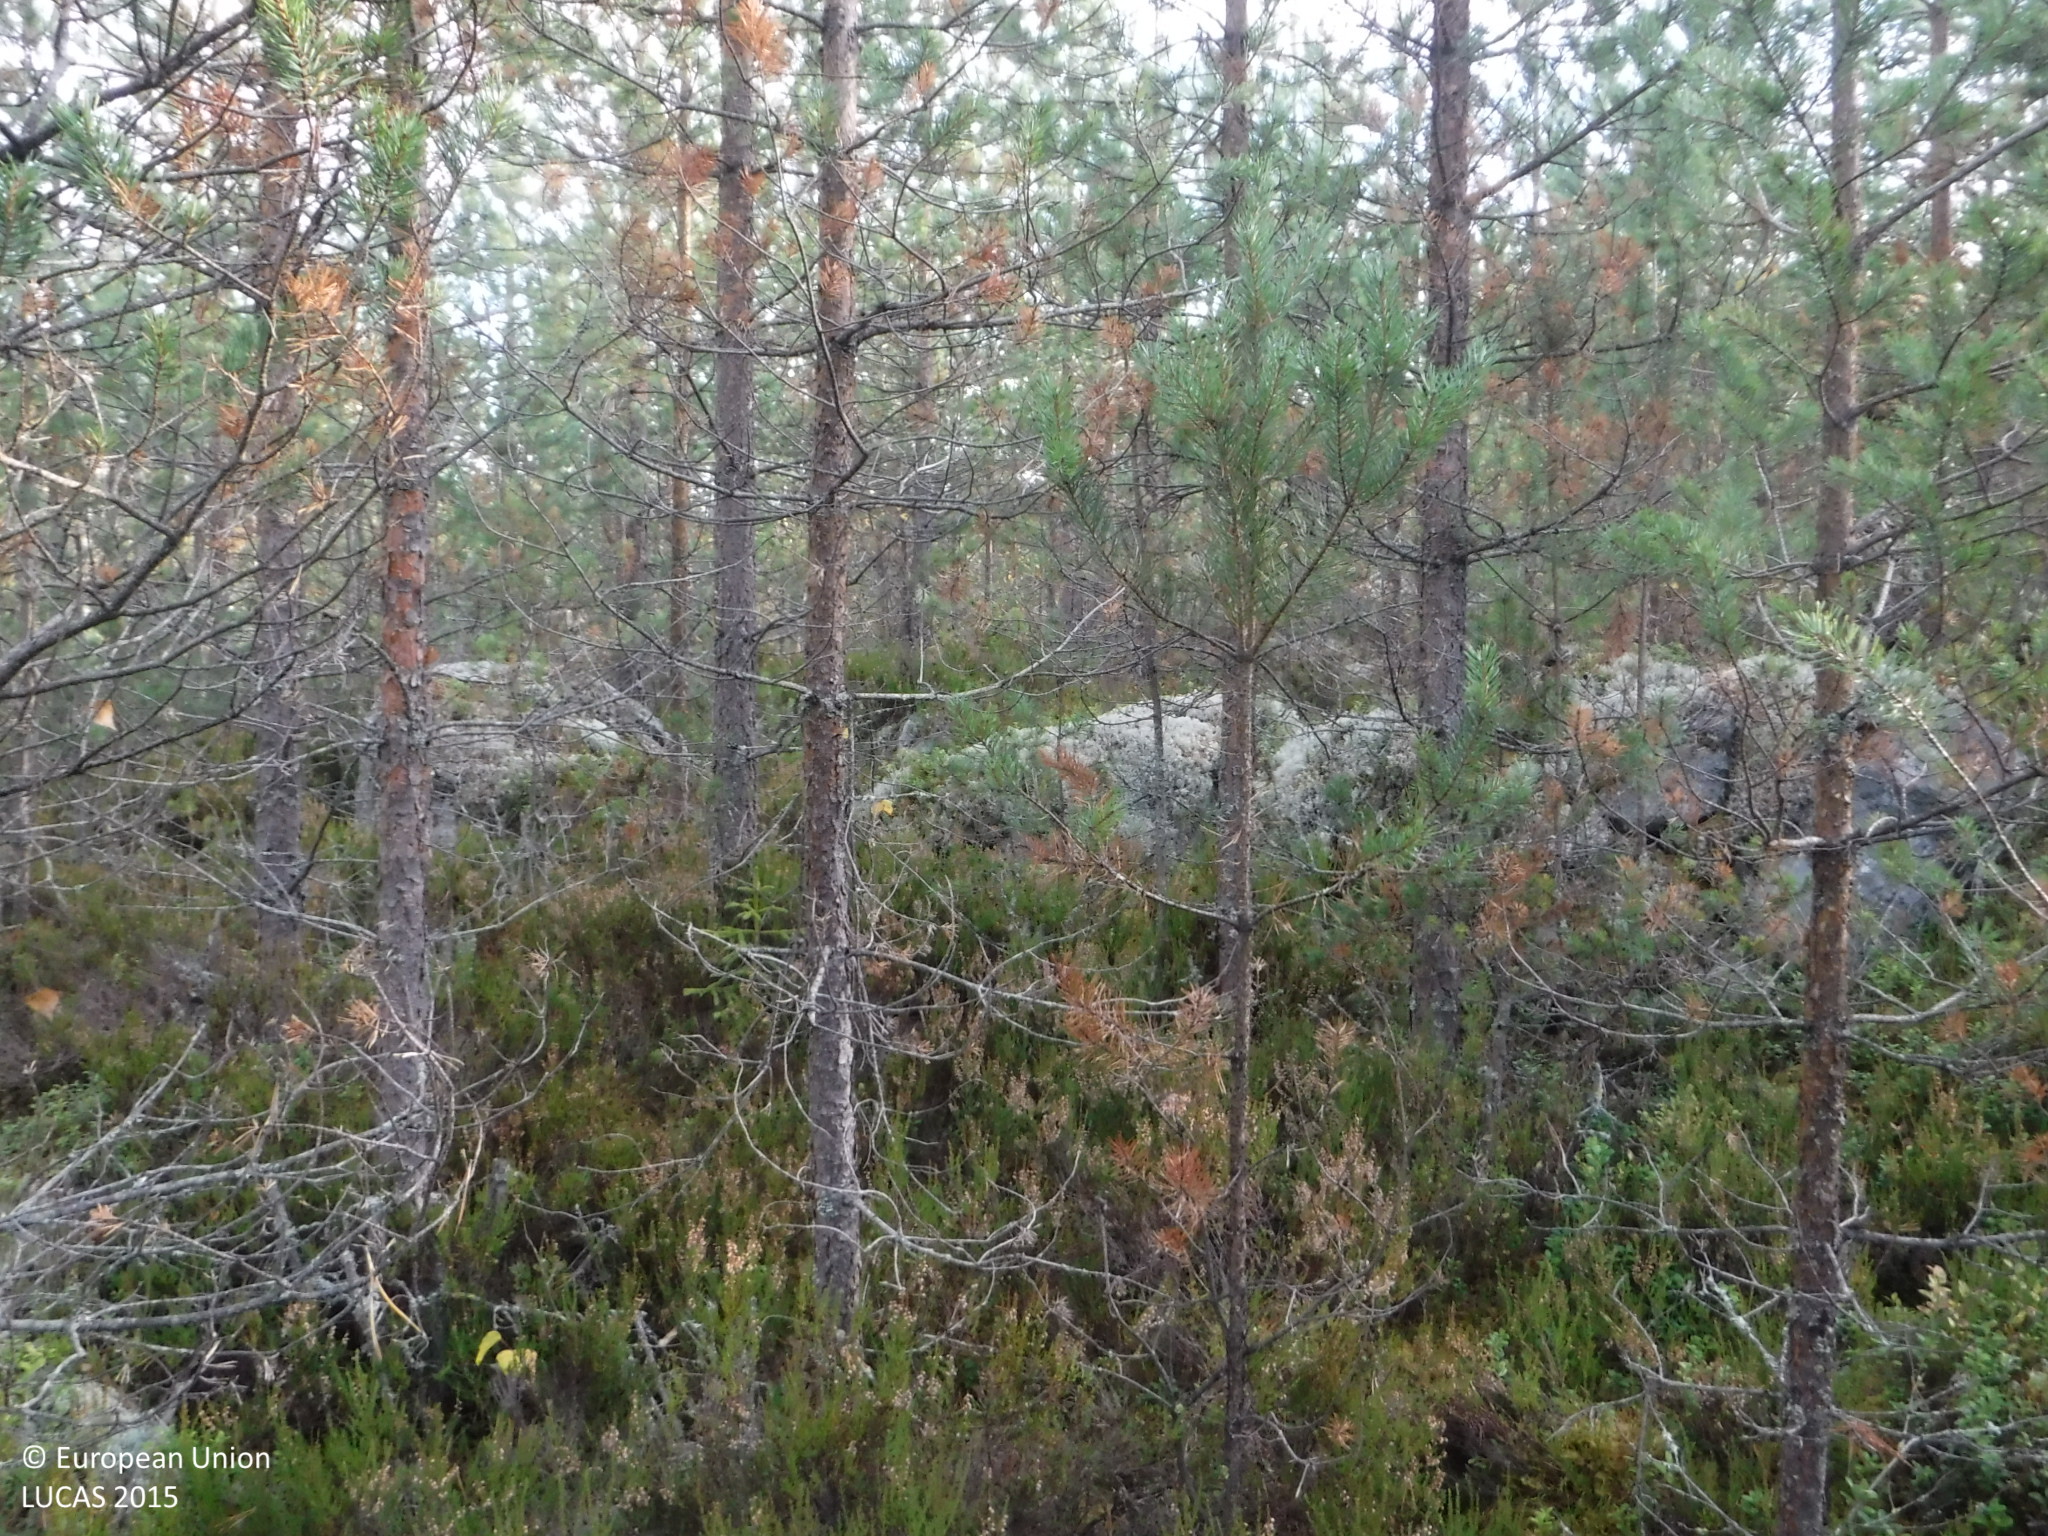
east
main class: Woodland
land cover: Pine dominated coniferous woodland
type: boreal forest
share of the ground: 50 - 75 %
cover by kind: coniferous forest trees 70 %, shrubs 15 %, lichens and mosses 15 %
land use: Forestry
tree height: < 5 m
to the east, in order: Pine dominated coniferous woodland; Other mixed woodland; Pine dominated mixed woodland; Pine dominated coniferous woodland
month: October
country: FI
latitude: 62.0417
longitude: 26.0178
